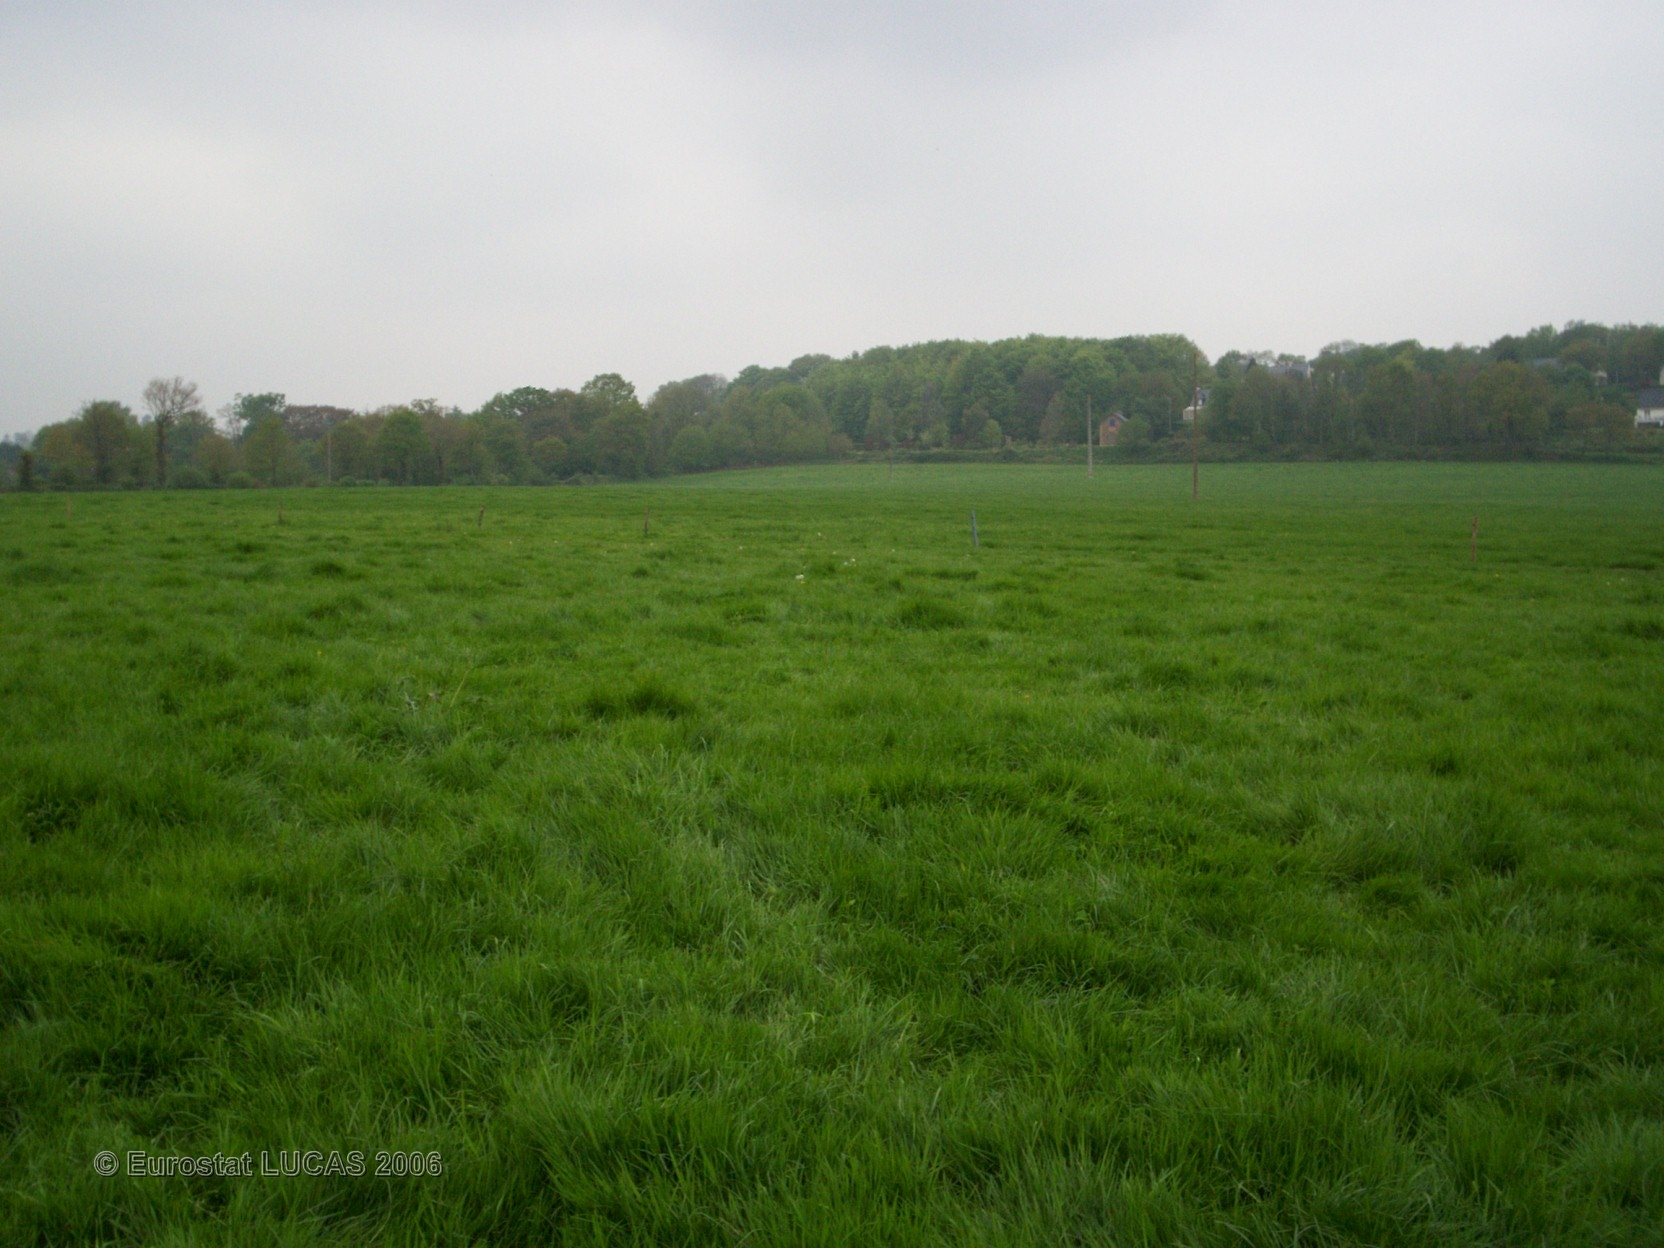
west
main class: Grassland
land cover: Grassland without tree/shrub cover
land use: Agriculture (excluding fallow land and kitchen gardens)
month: May
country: FR
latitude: 48.2004
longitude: -2.9712
